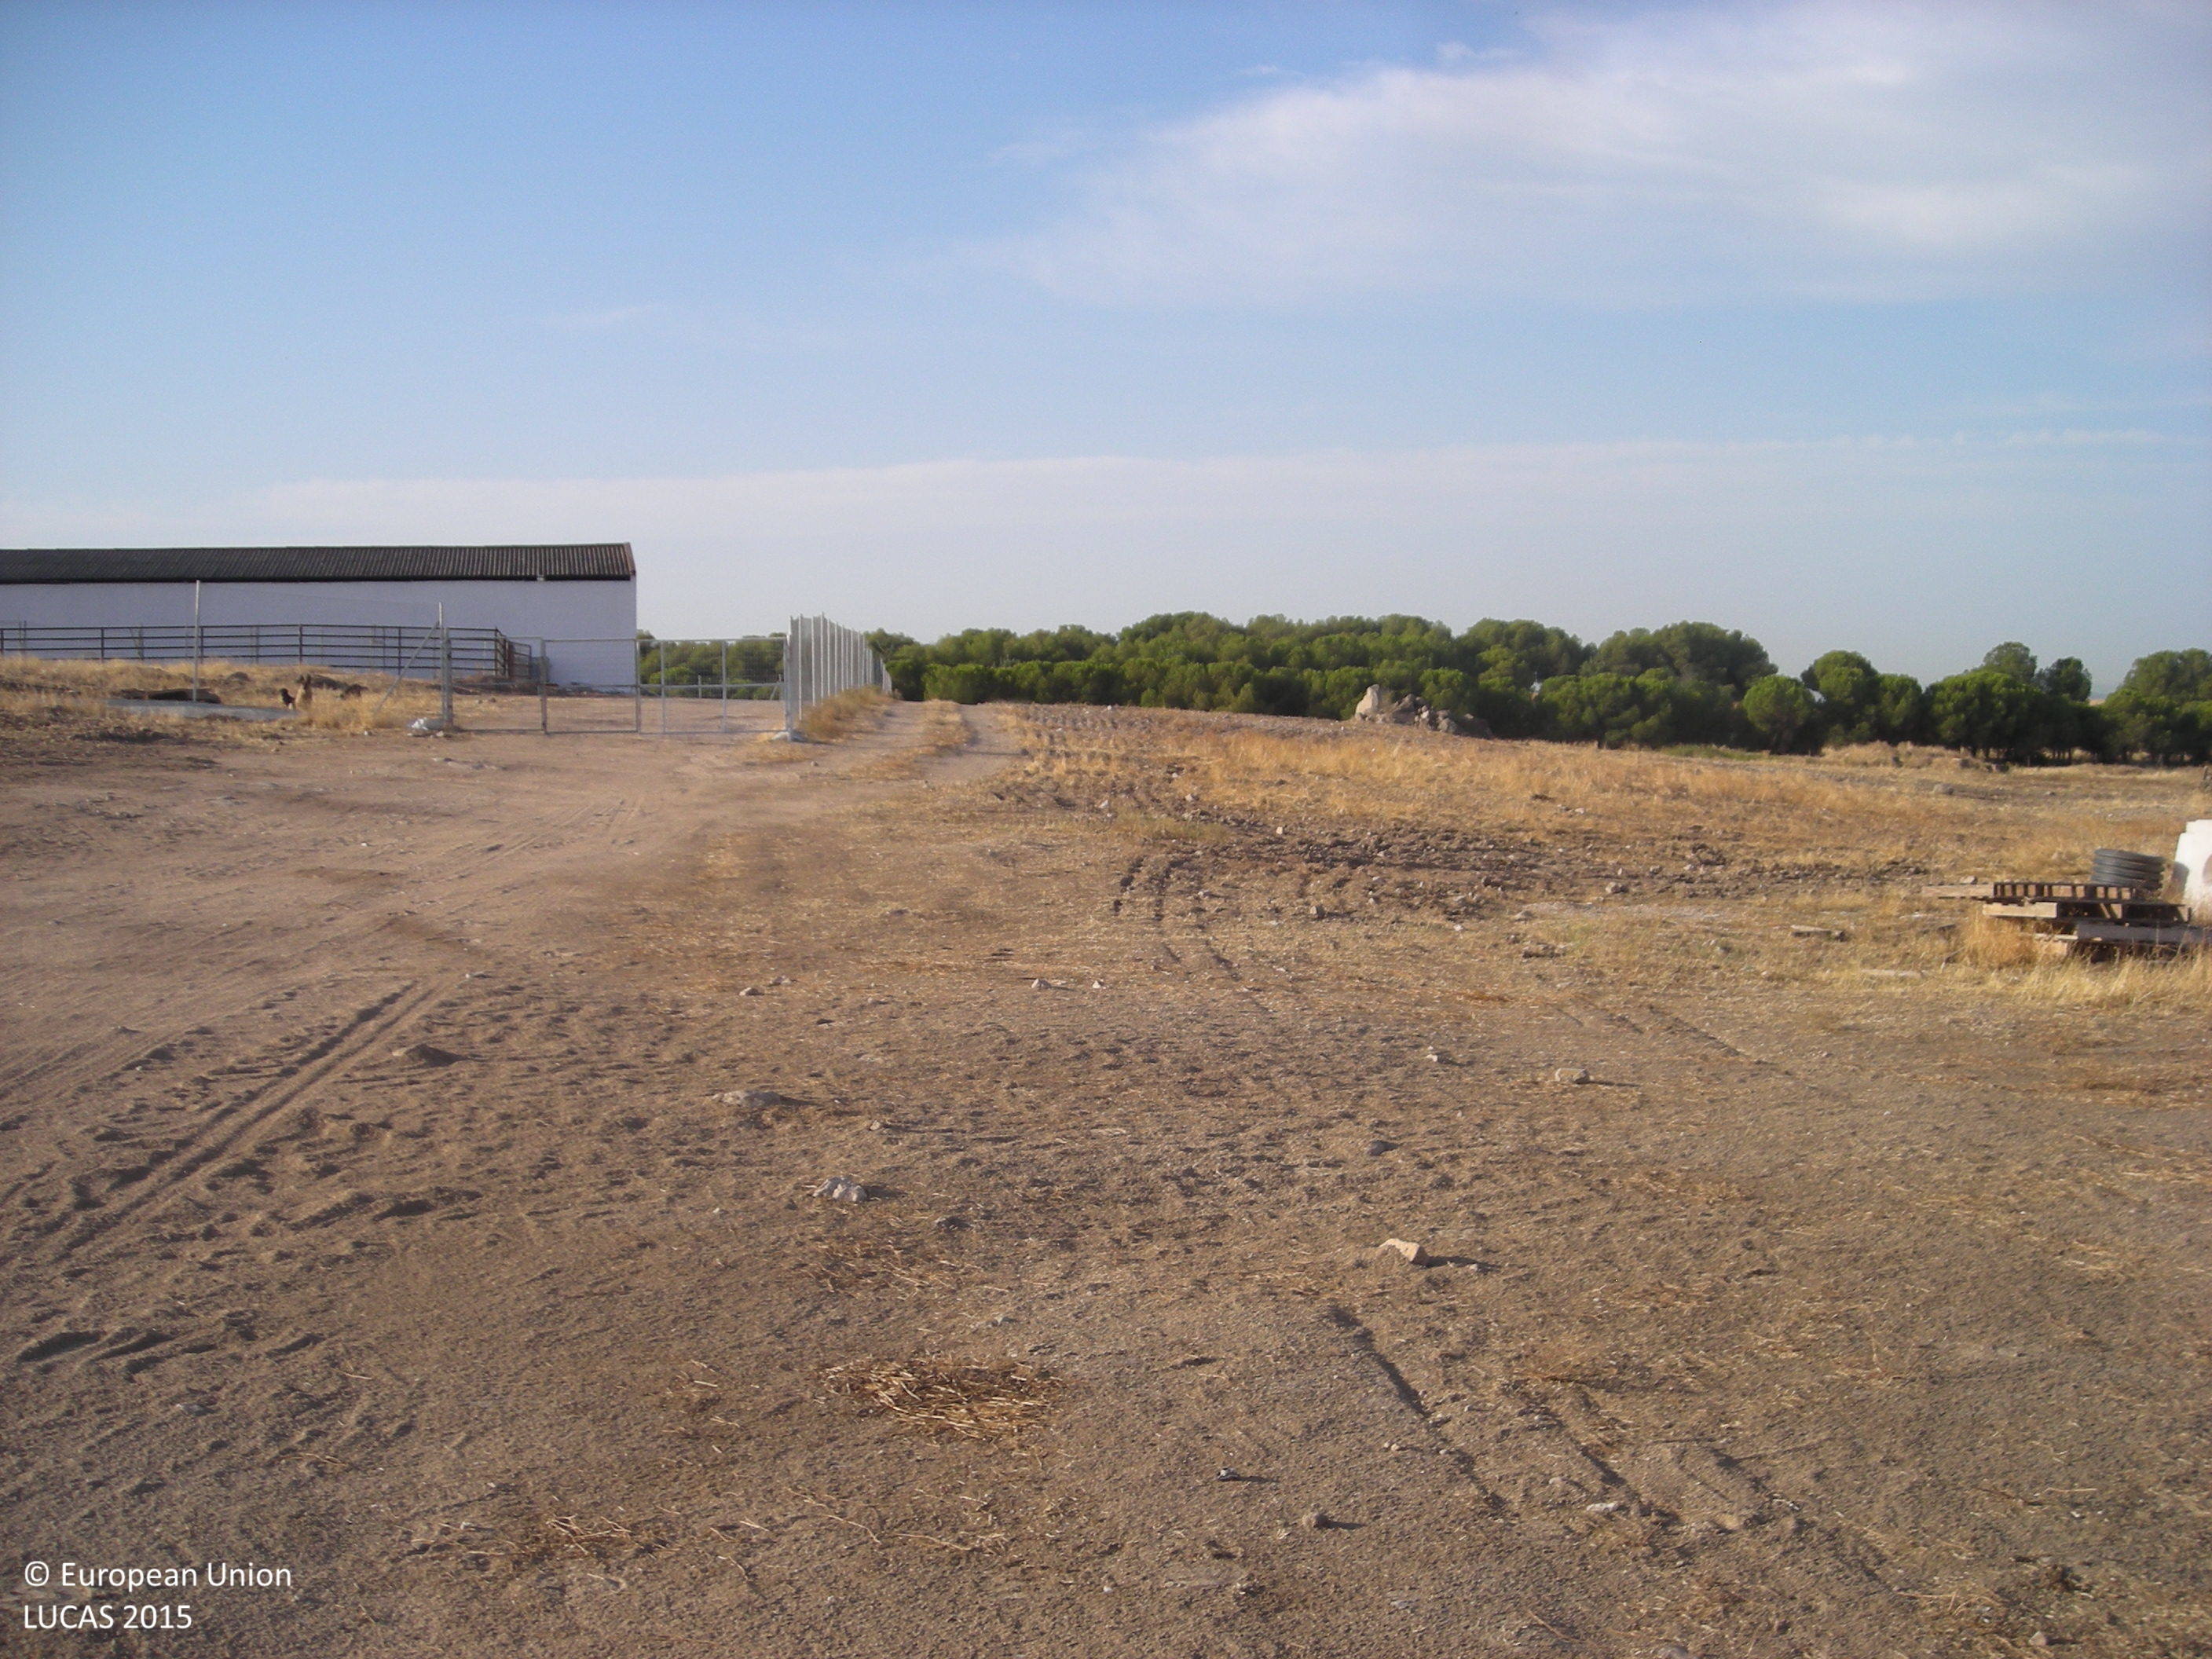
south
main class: Grassland
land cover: Spontaneously vegetated surfaces
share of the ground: > 75 %
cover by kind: herbaceous plants 100 %
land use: Agriculture (excluding fallow land and kitchen gardens)
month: July
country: ES
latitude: 39.1352
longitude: -5.9612
